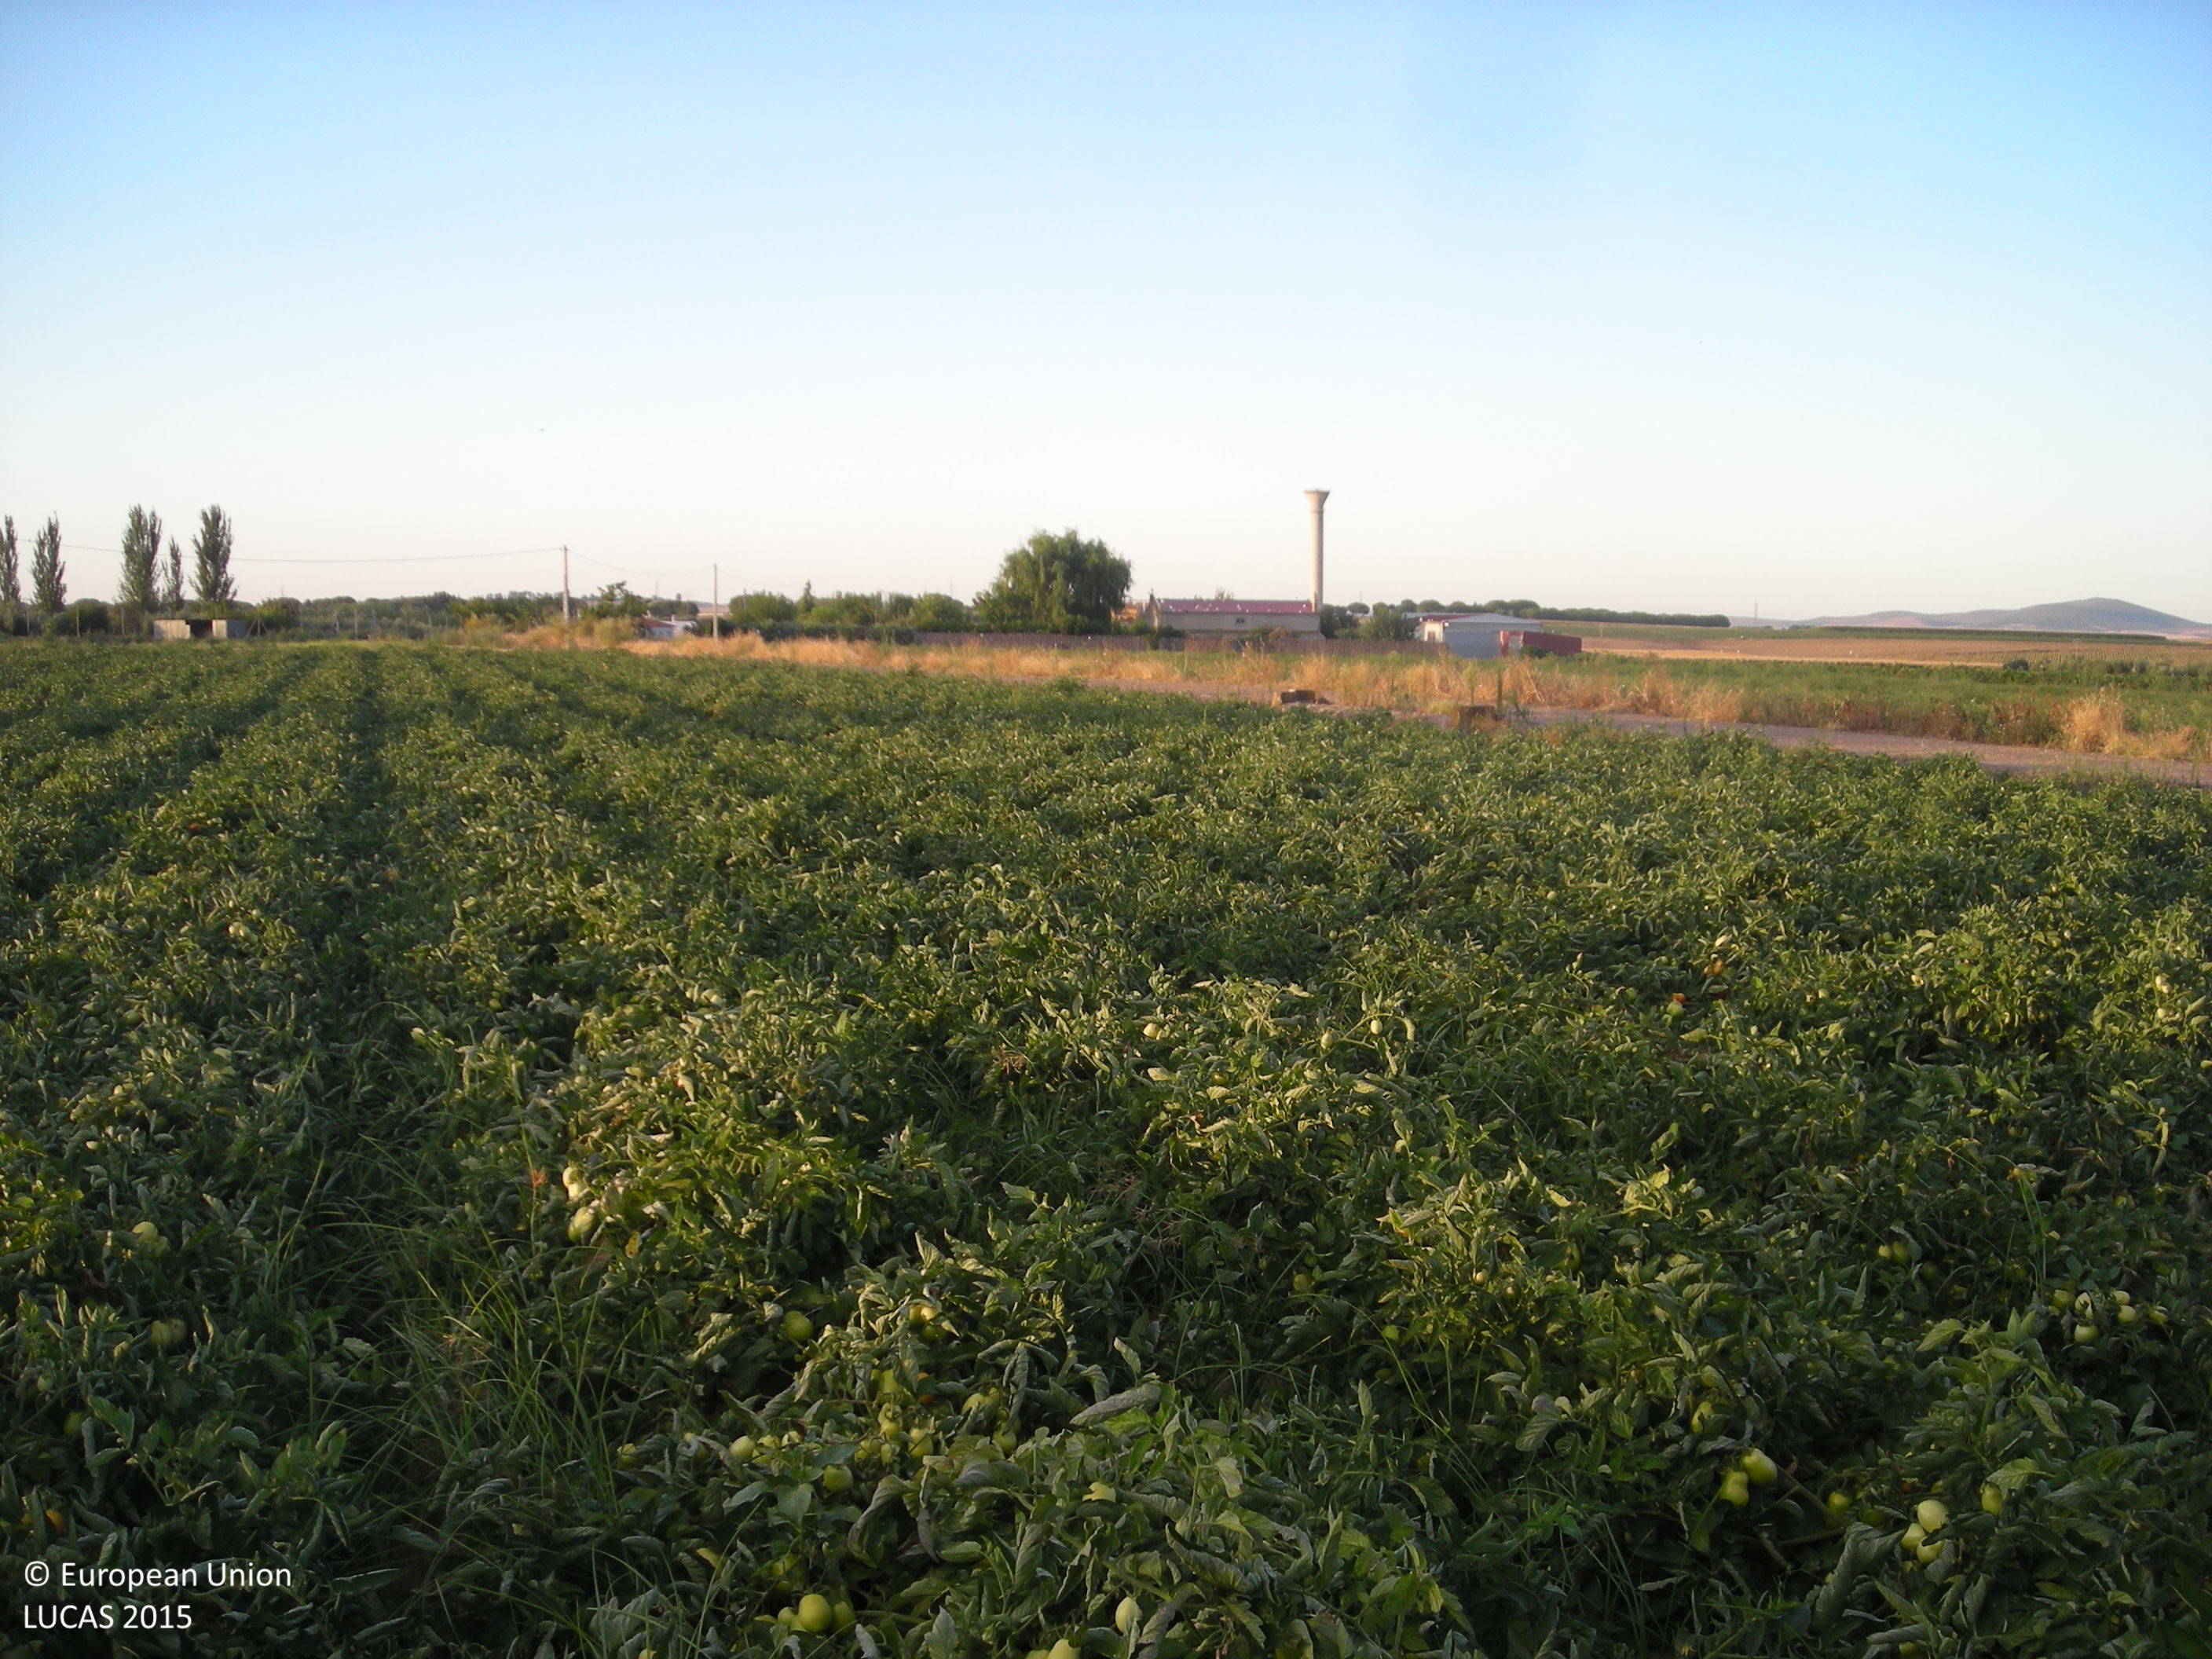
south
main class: Cropland
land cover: Tomatoes
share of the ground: > 75 %
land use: Agriculture (excluding fallow land and kitchen gardens)
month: July
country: ES
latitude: 38.9331
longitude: -5.9586
